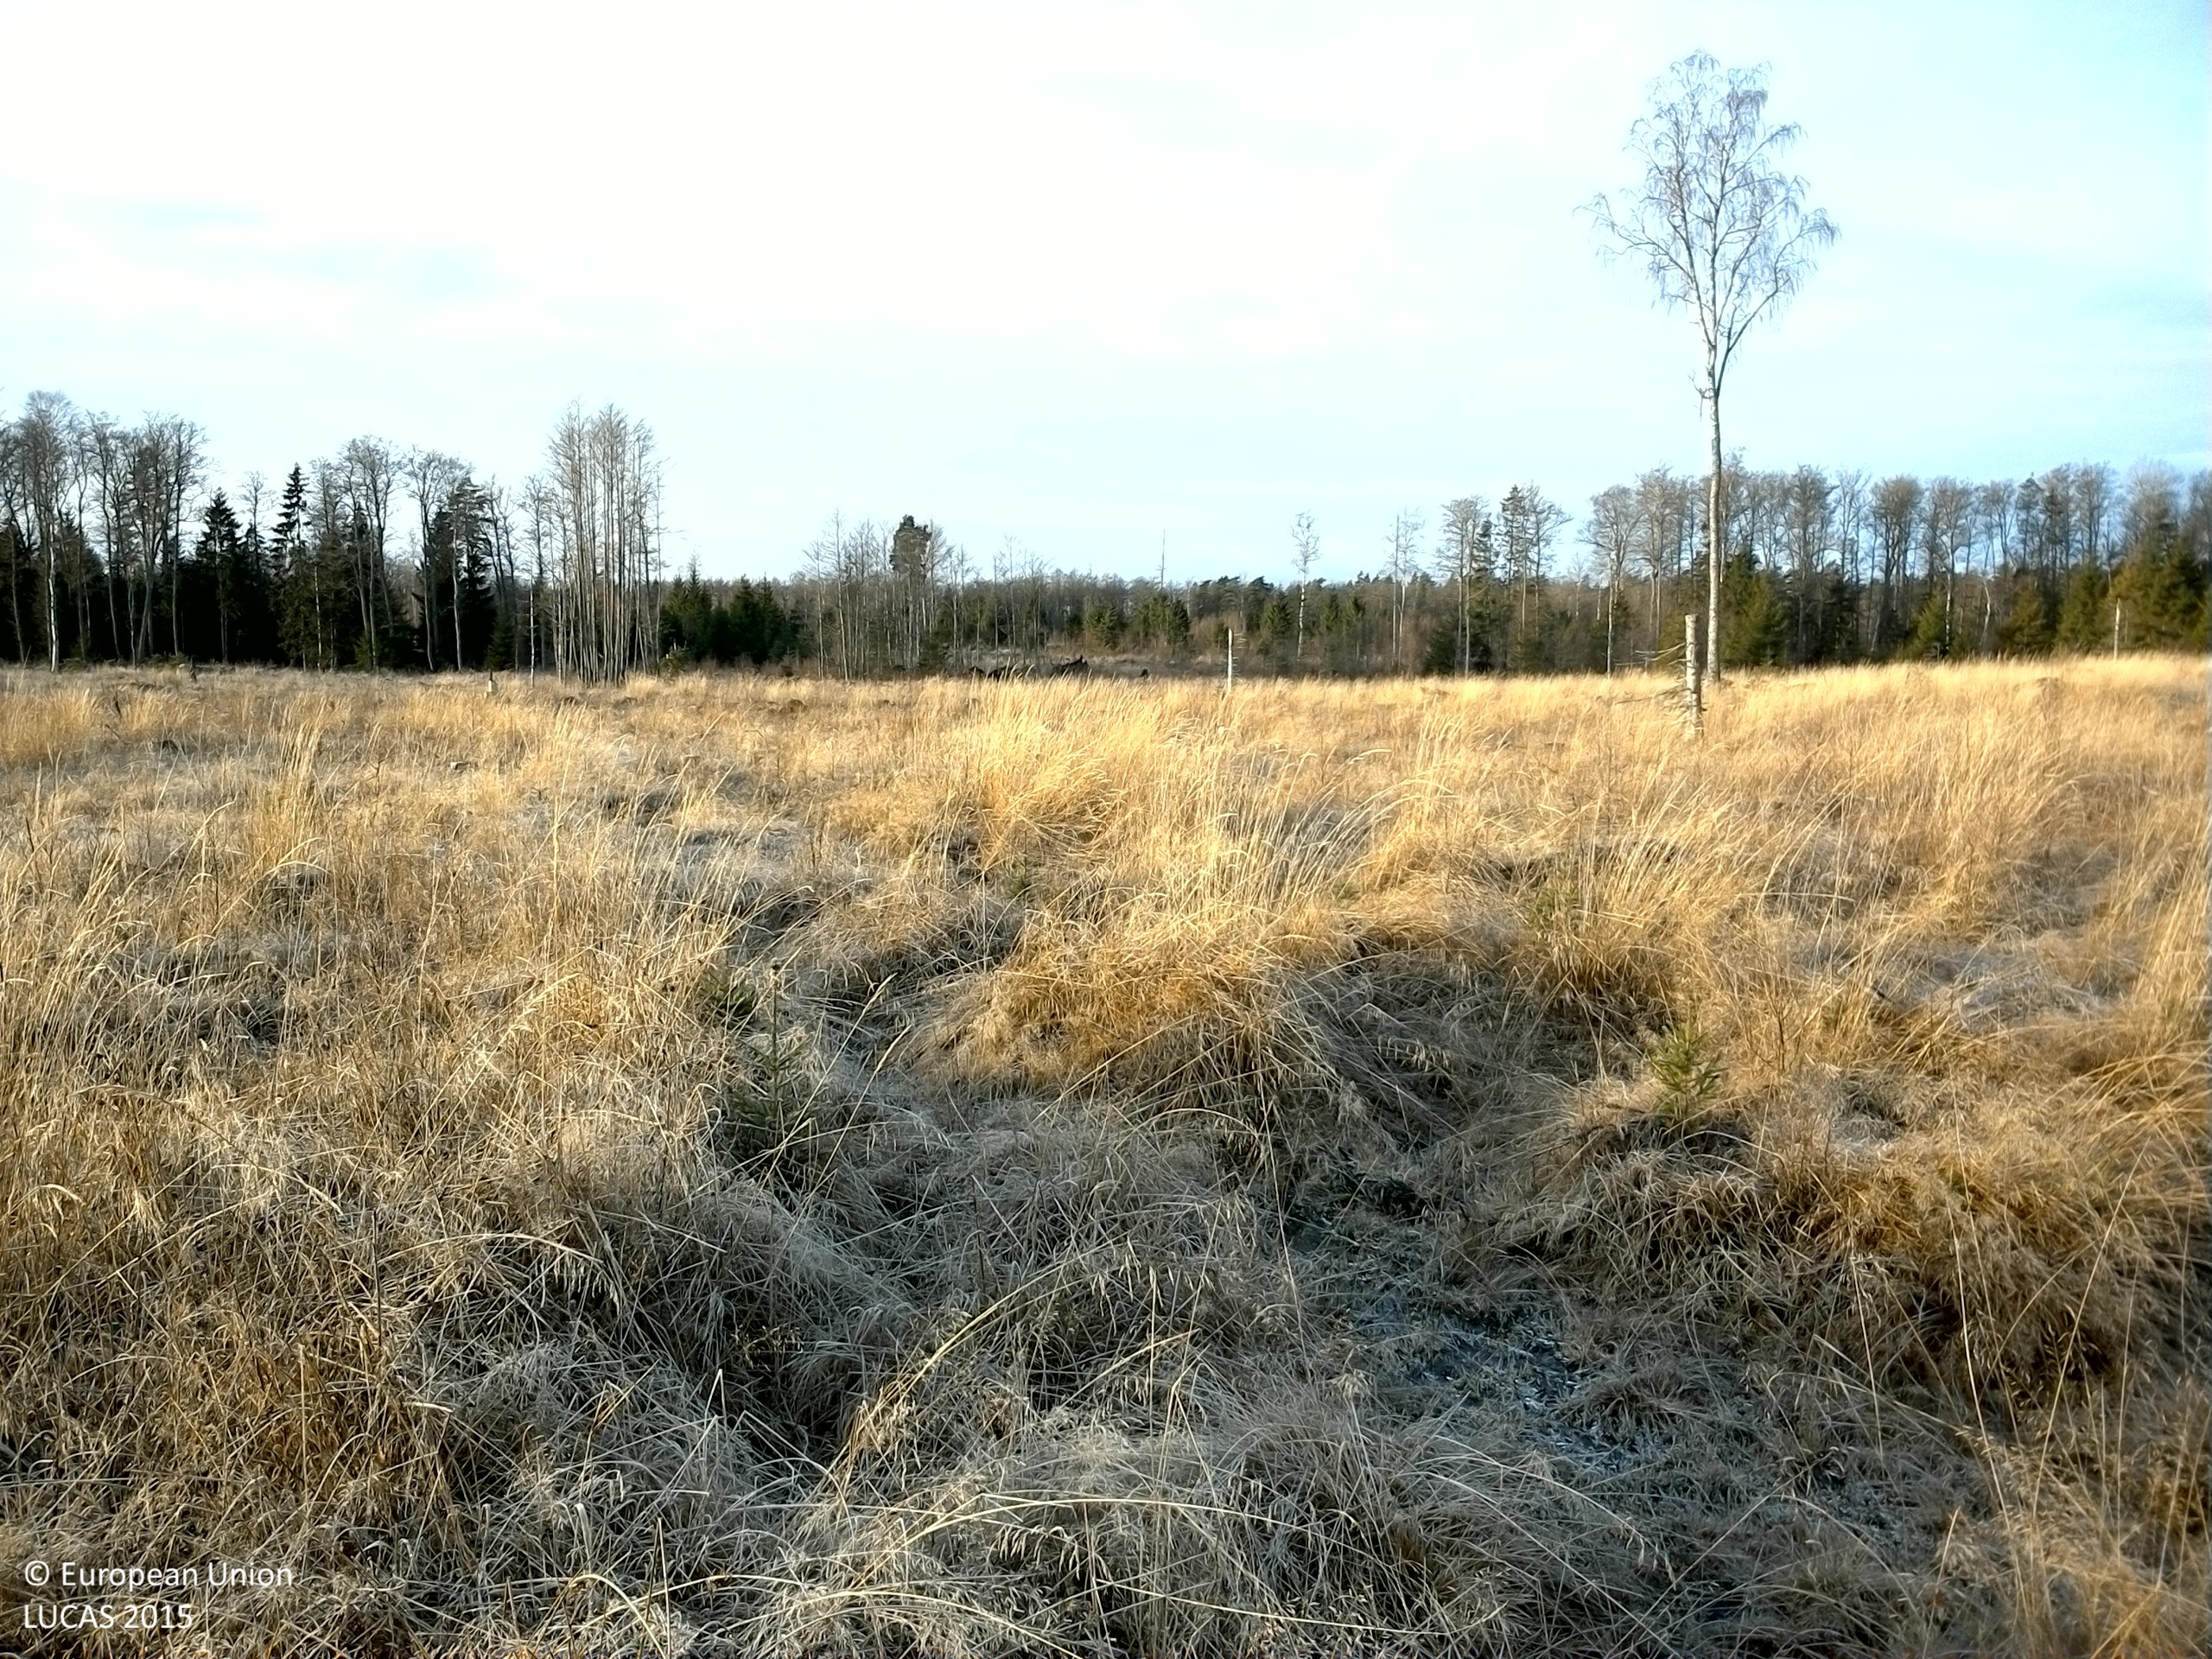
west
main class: Grassland
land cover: Grassland with sparse tree/shrub cover
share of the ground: > 75 %
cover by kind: herbaceous plants 85 %, coniferous forest trees 5 %, shrubs 5 %, consolidated bare surface 5 %
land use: Forestry
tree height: < 5 m
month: December
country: SE
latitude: 59.7503
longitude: 16.7012
